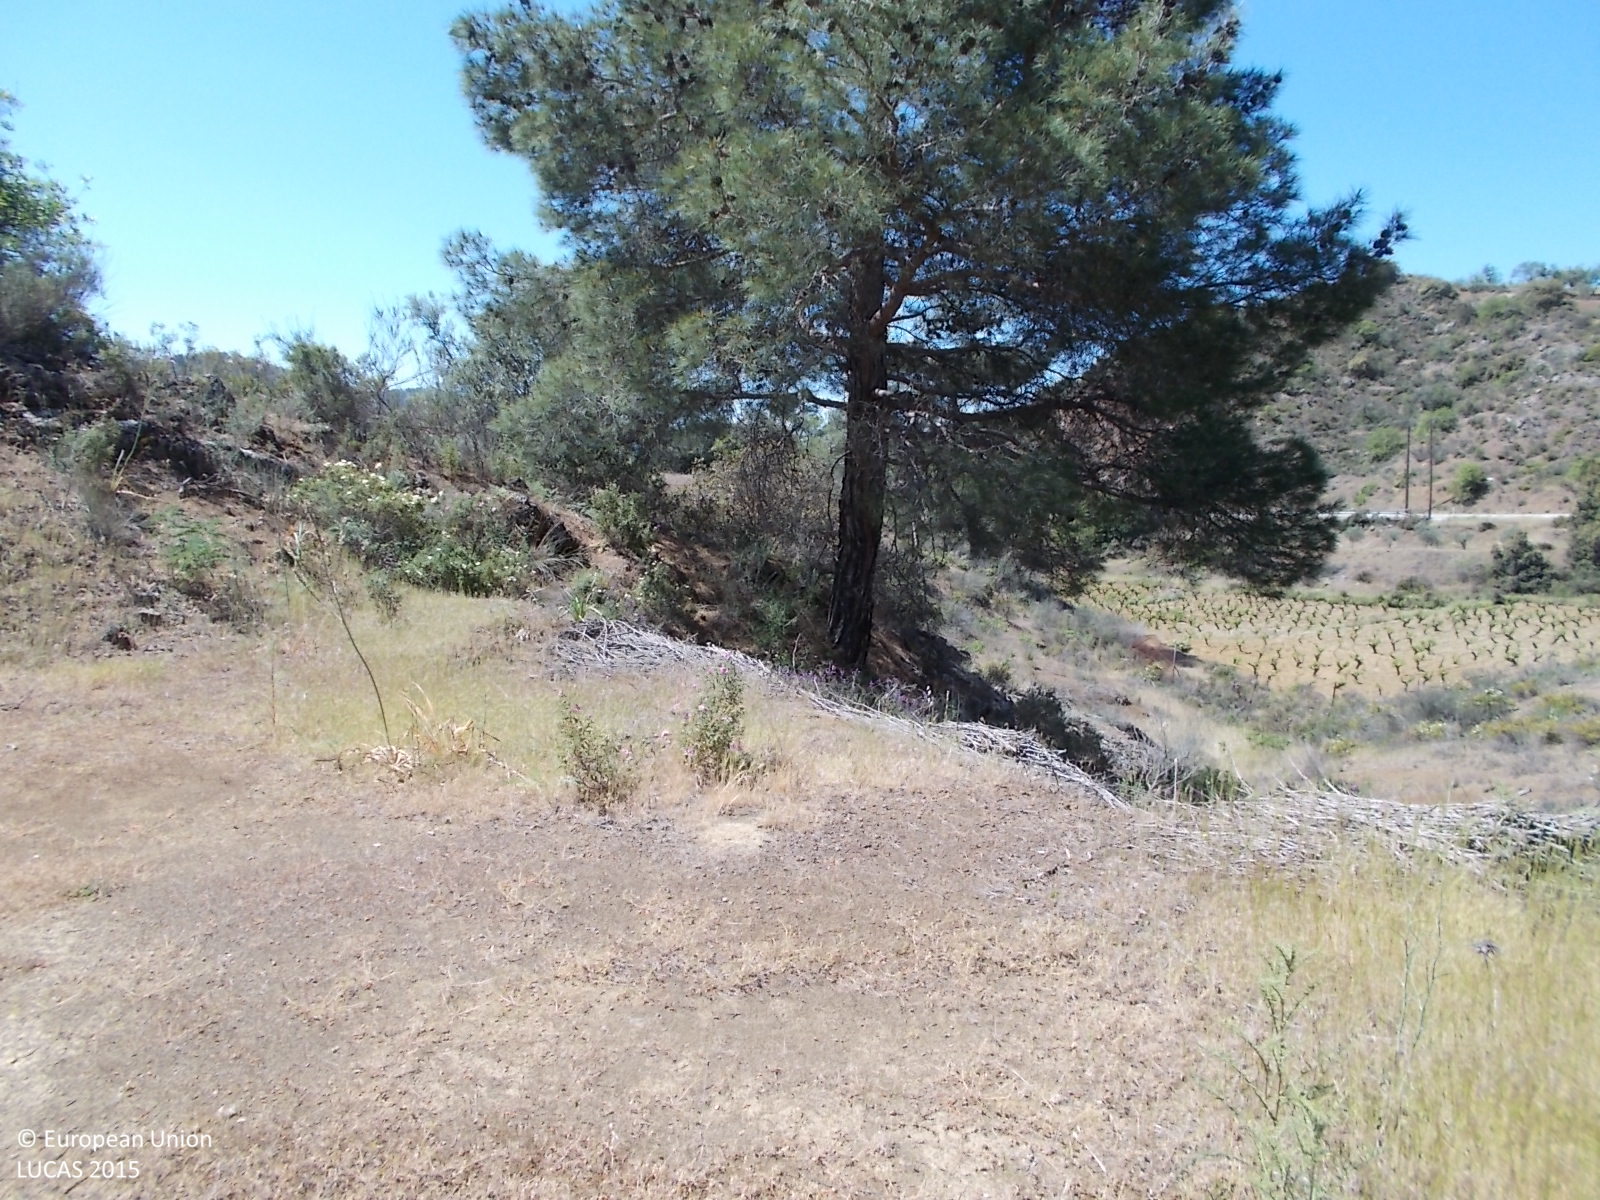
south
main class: Cropland
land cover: Vineyards
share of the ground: > 75 %
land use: Agriculture (excluding fallow land and kitchen gardens)
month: May
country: CY
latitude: 34.8463
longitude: 33.0153
